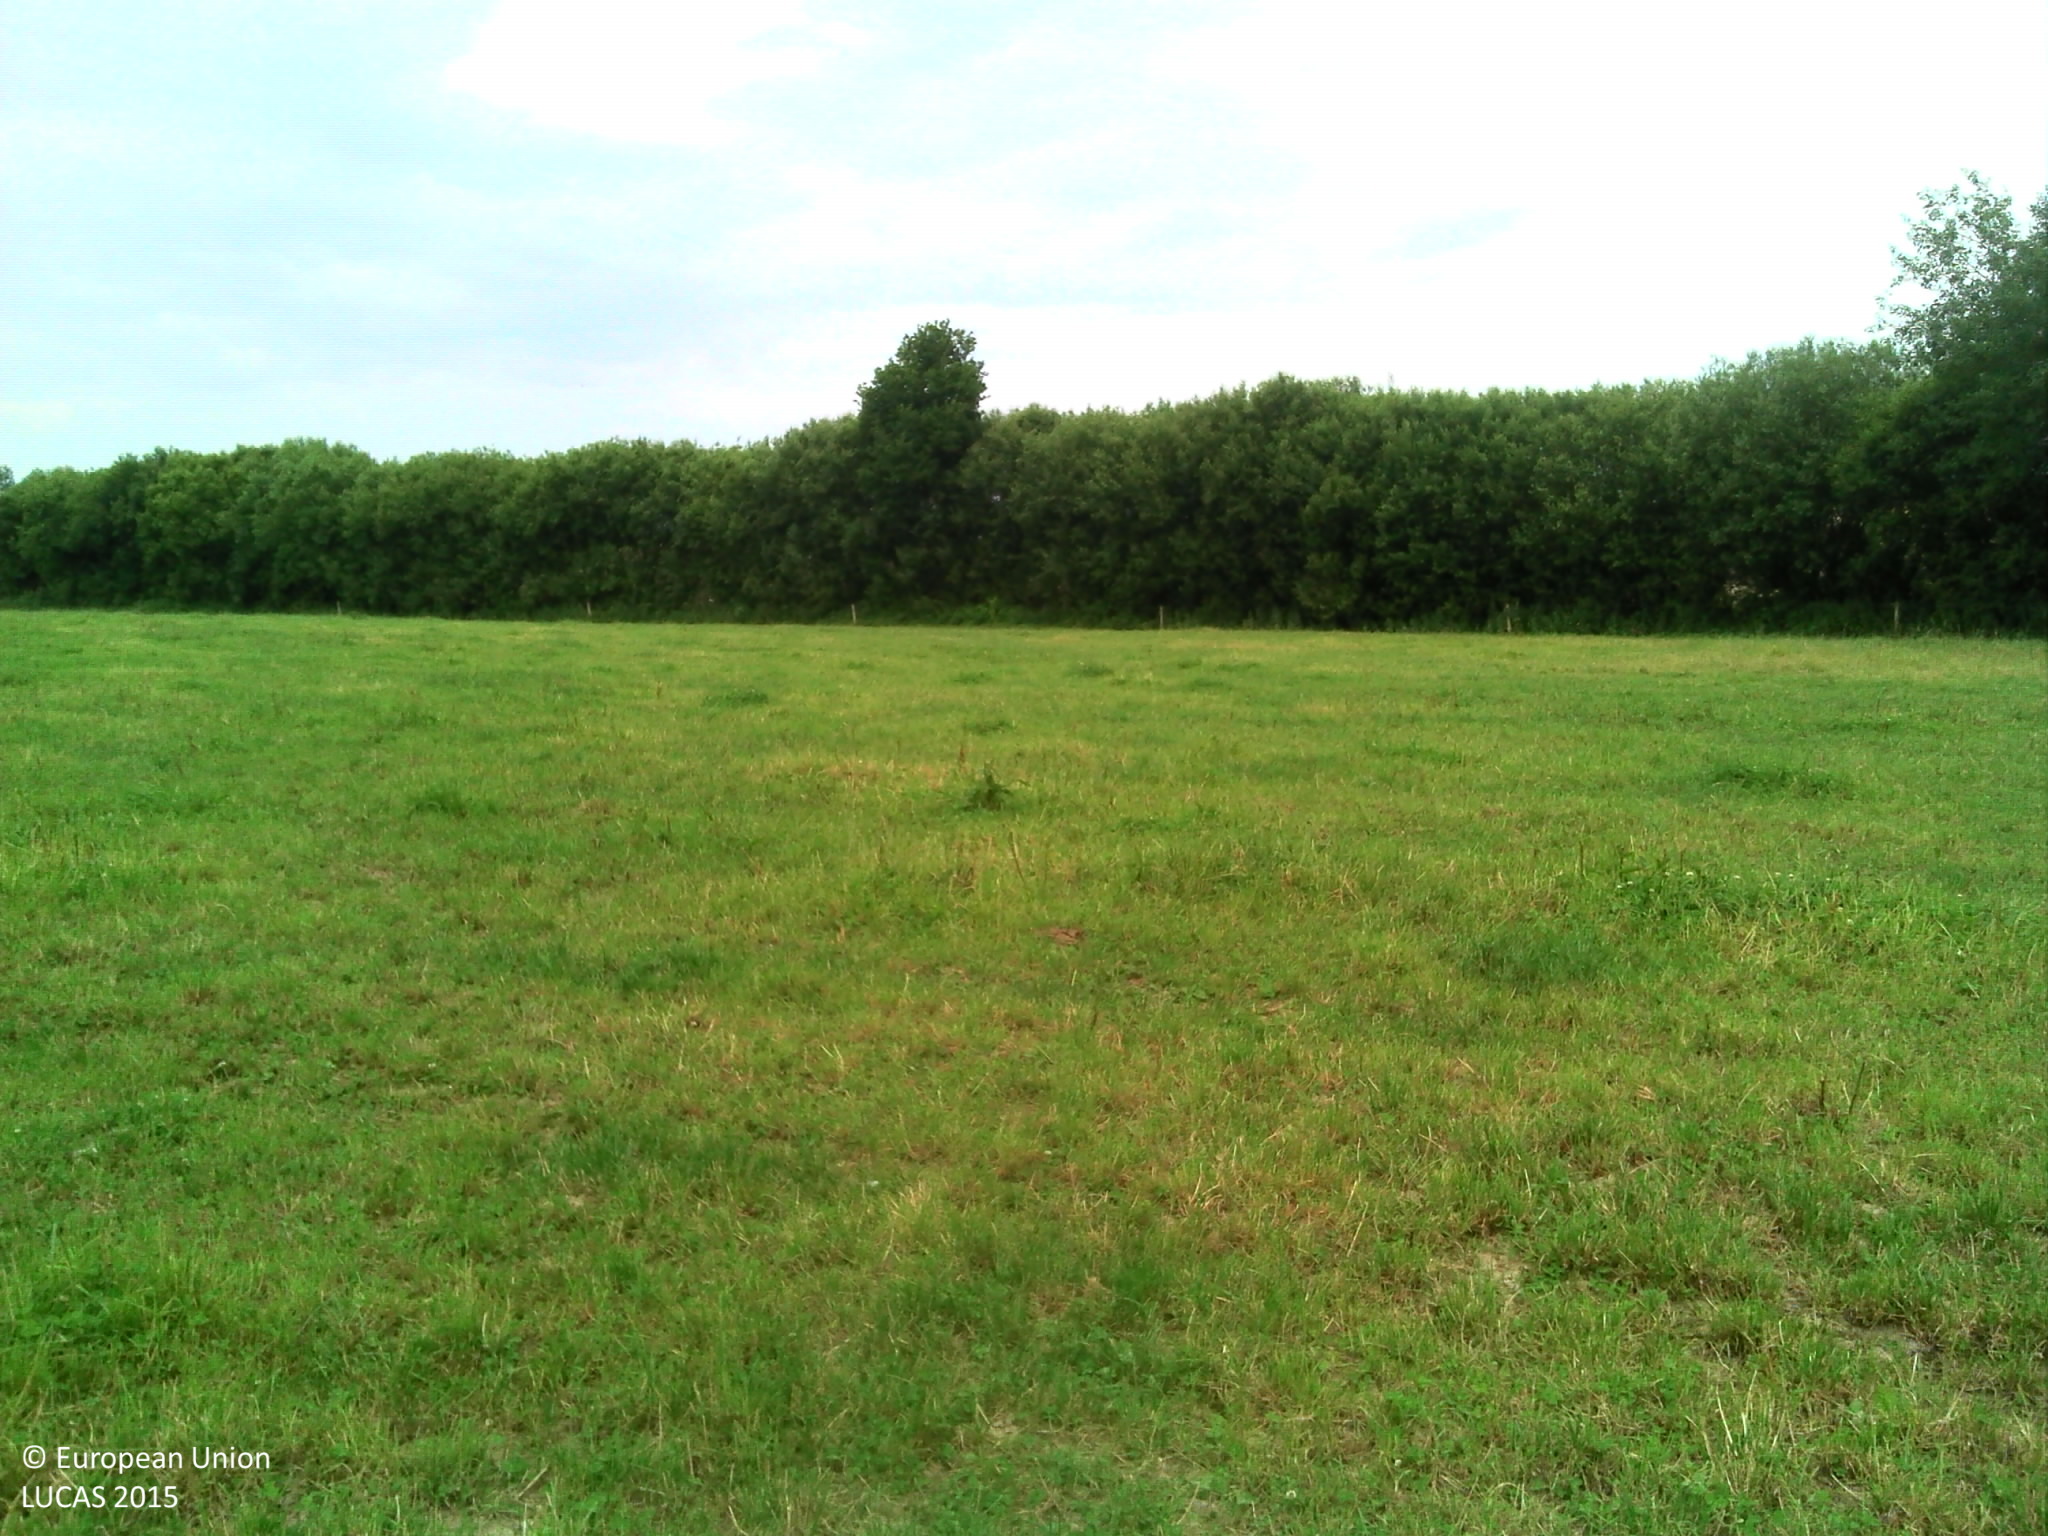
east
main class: Grassland
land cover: Grassland without tree/shrub cover
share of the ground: > 75 %
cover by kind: herbaceous plants 100 %
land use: Agriculture (excluding fallow land and kitchen gardens)
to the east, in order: Grassland without tree/shrub cover; Fences; Managed hedges; Ditches and canals; Managed hedges; Sunflower
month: June
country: FR
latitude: 46.7814
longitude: -1.6857
